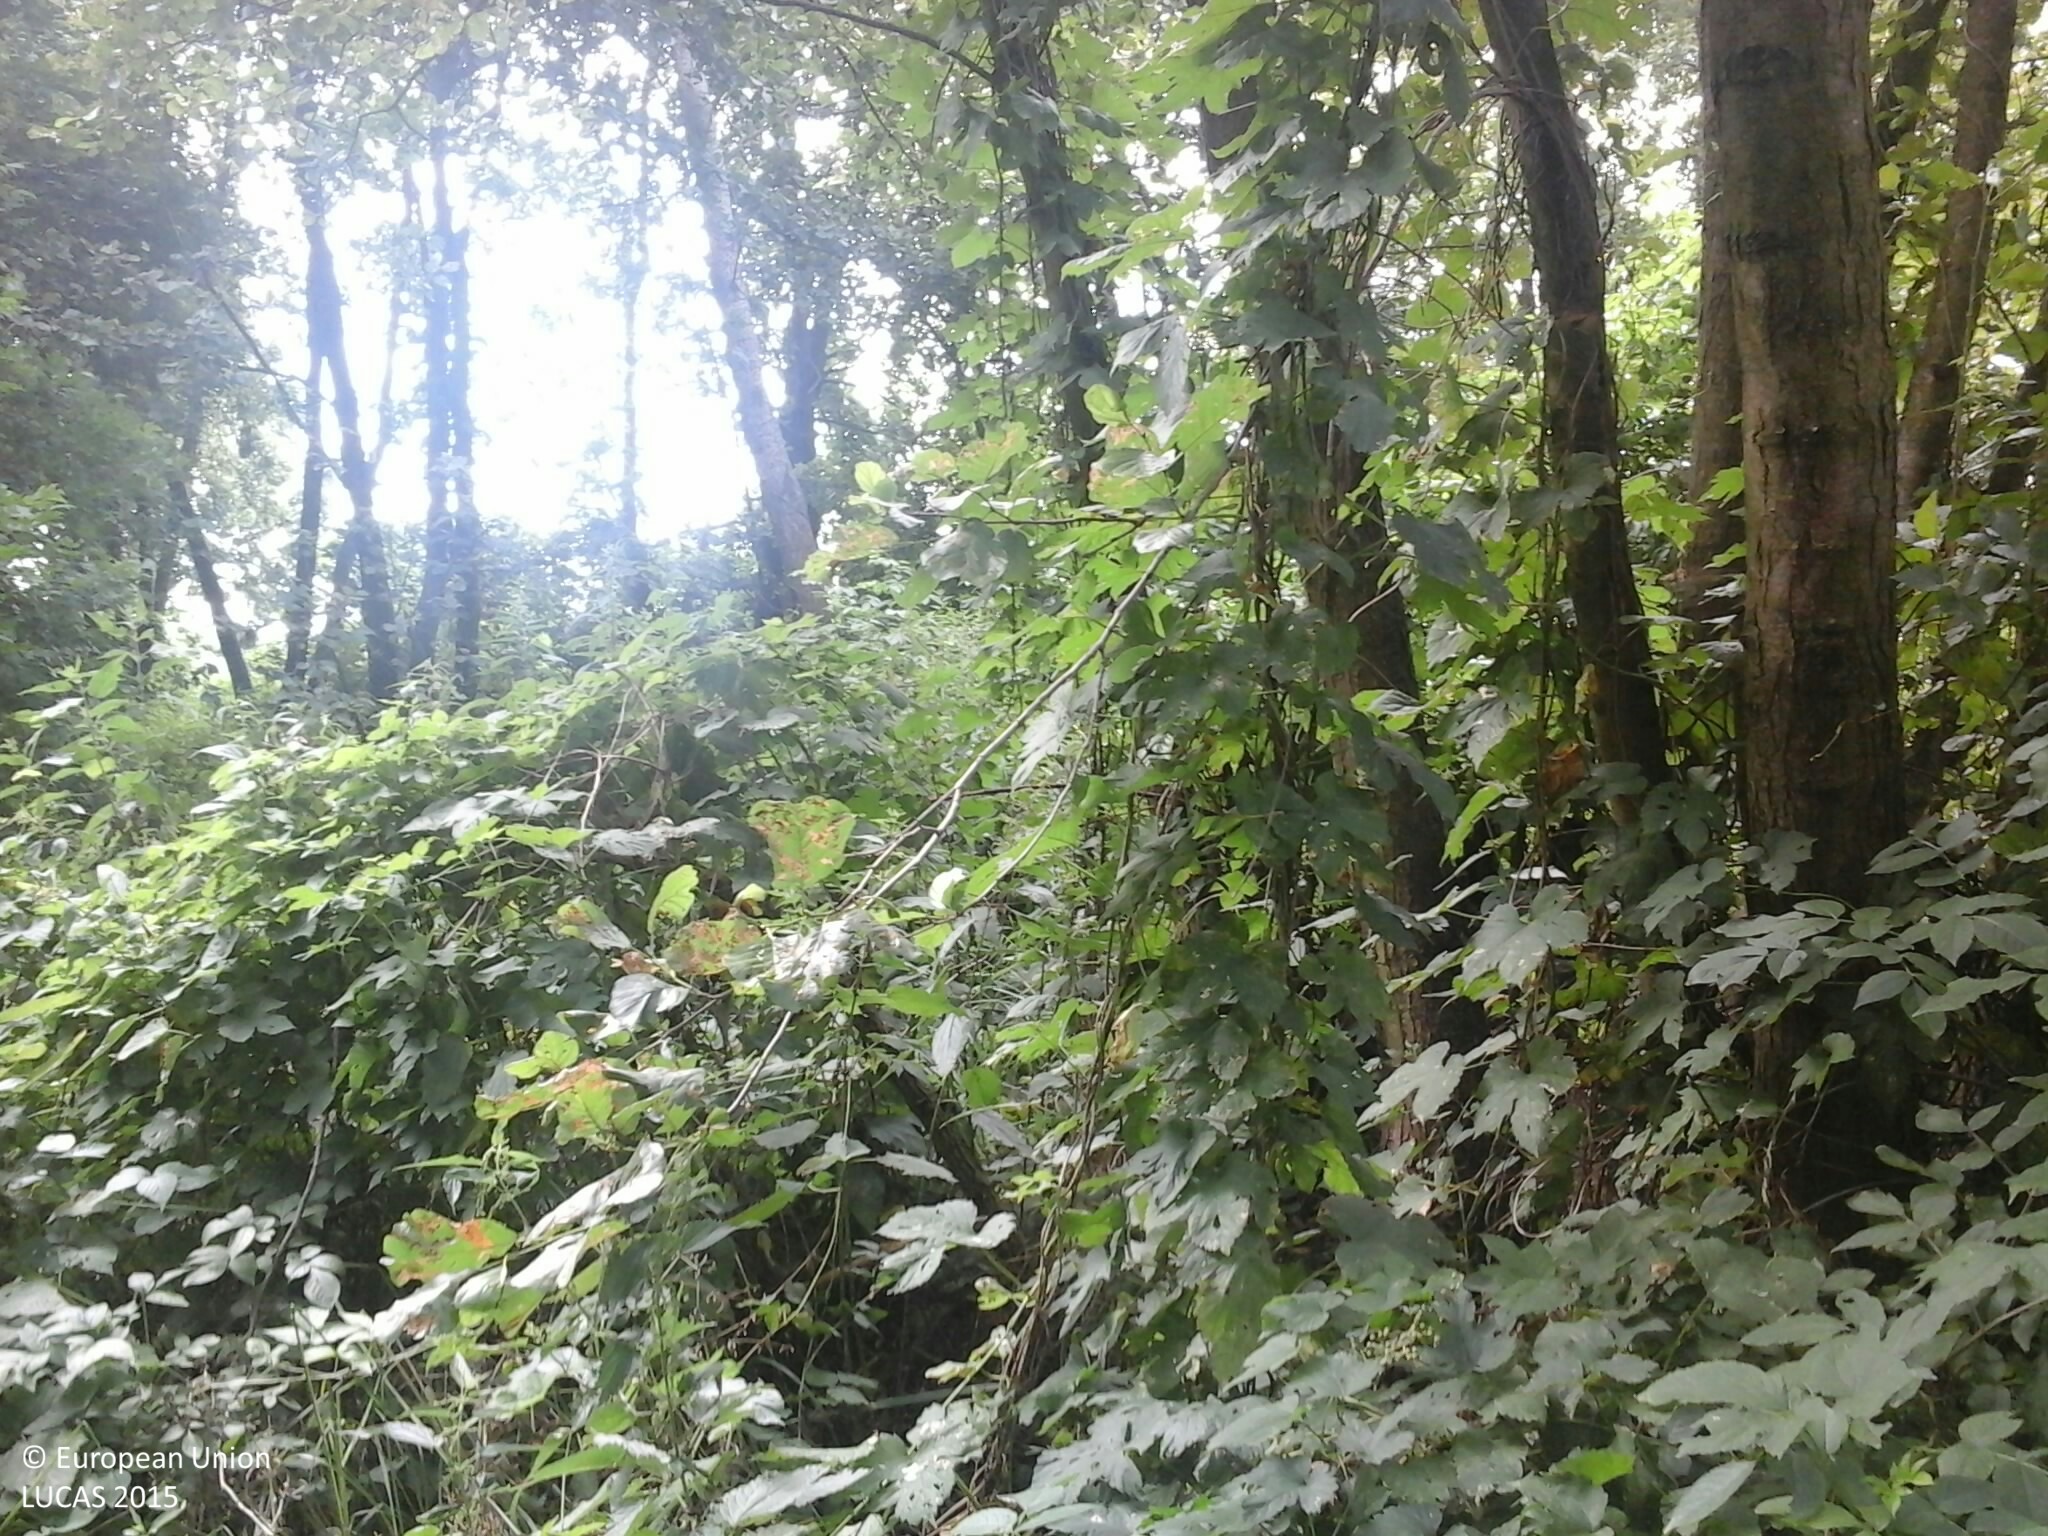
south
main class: Woodland
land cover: Broadleaved woodland
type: mesophytic deciduous forest
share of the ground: > 75 %
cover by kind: broadleaved forest trees 85 %, herbaceous plants 15 %
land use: Abandoned areas
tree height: > 5 m
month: July
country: HU
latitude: 47.8933
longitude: 22.3212
